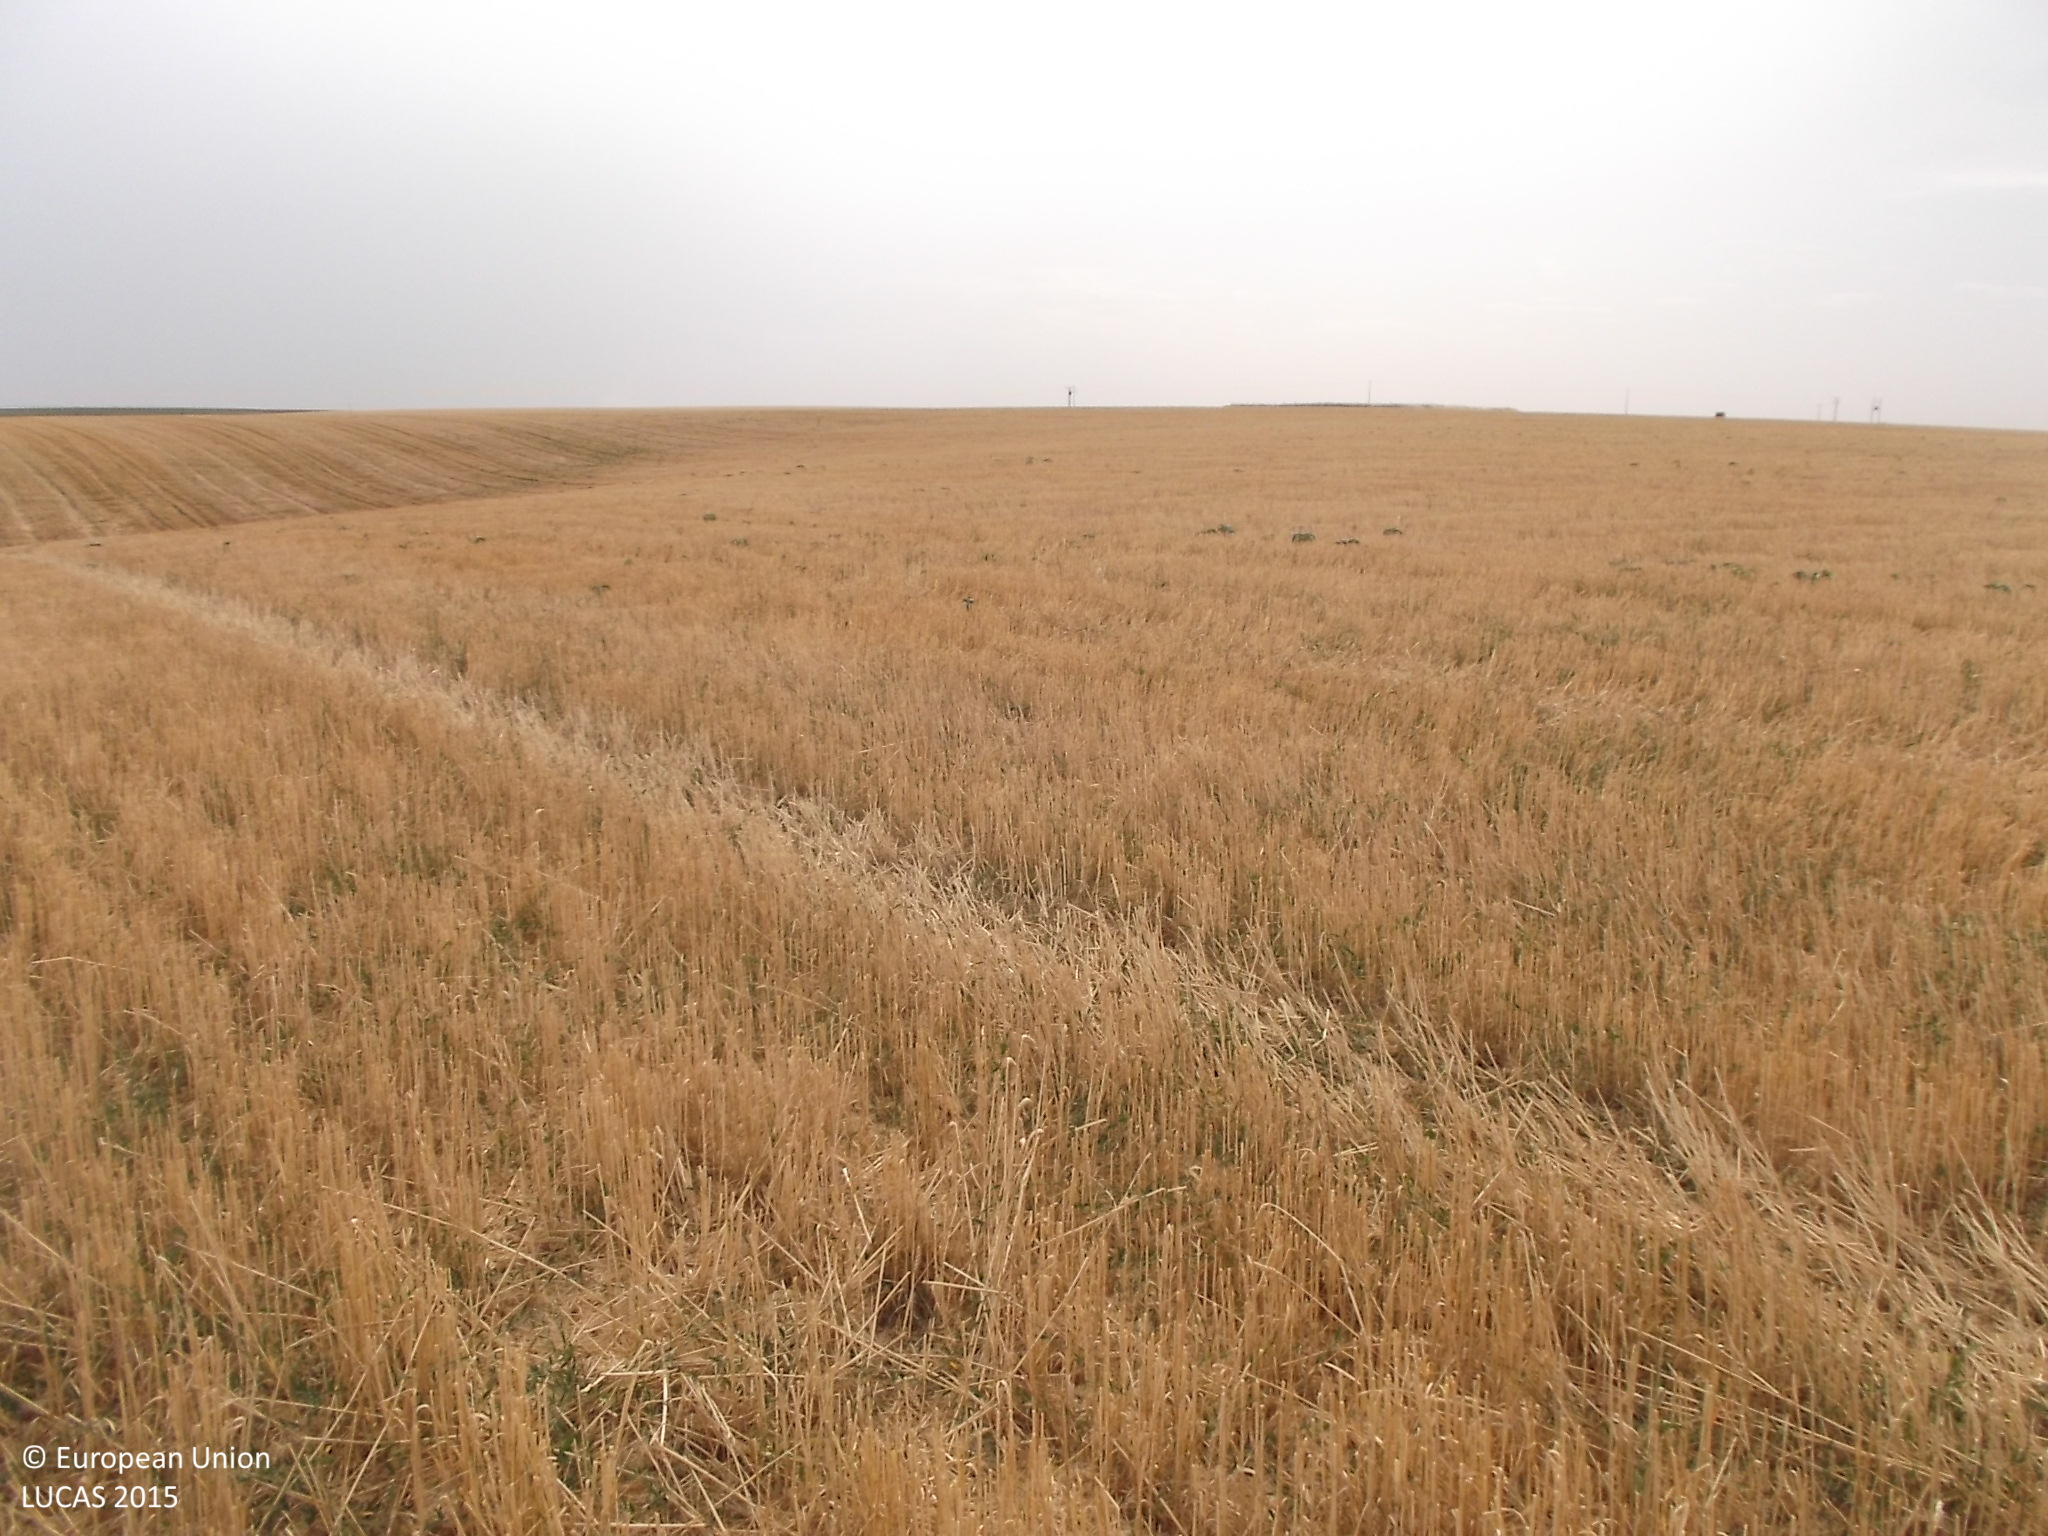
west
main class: Cropland
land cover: Common wheat
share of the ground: < 10 %
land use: Agriculture (excluding fallow land and kitchen gardens)
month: July
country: ES
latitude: 41.5640
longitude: -5.4910
